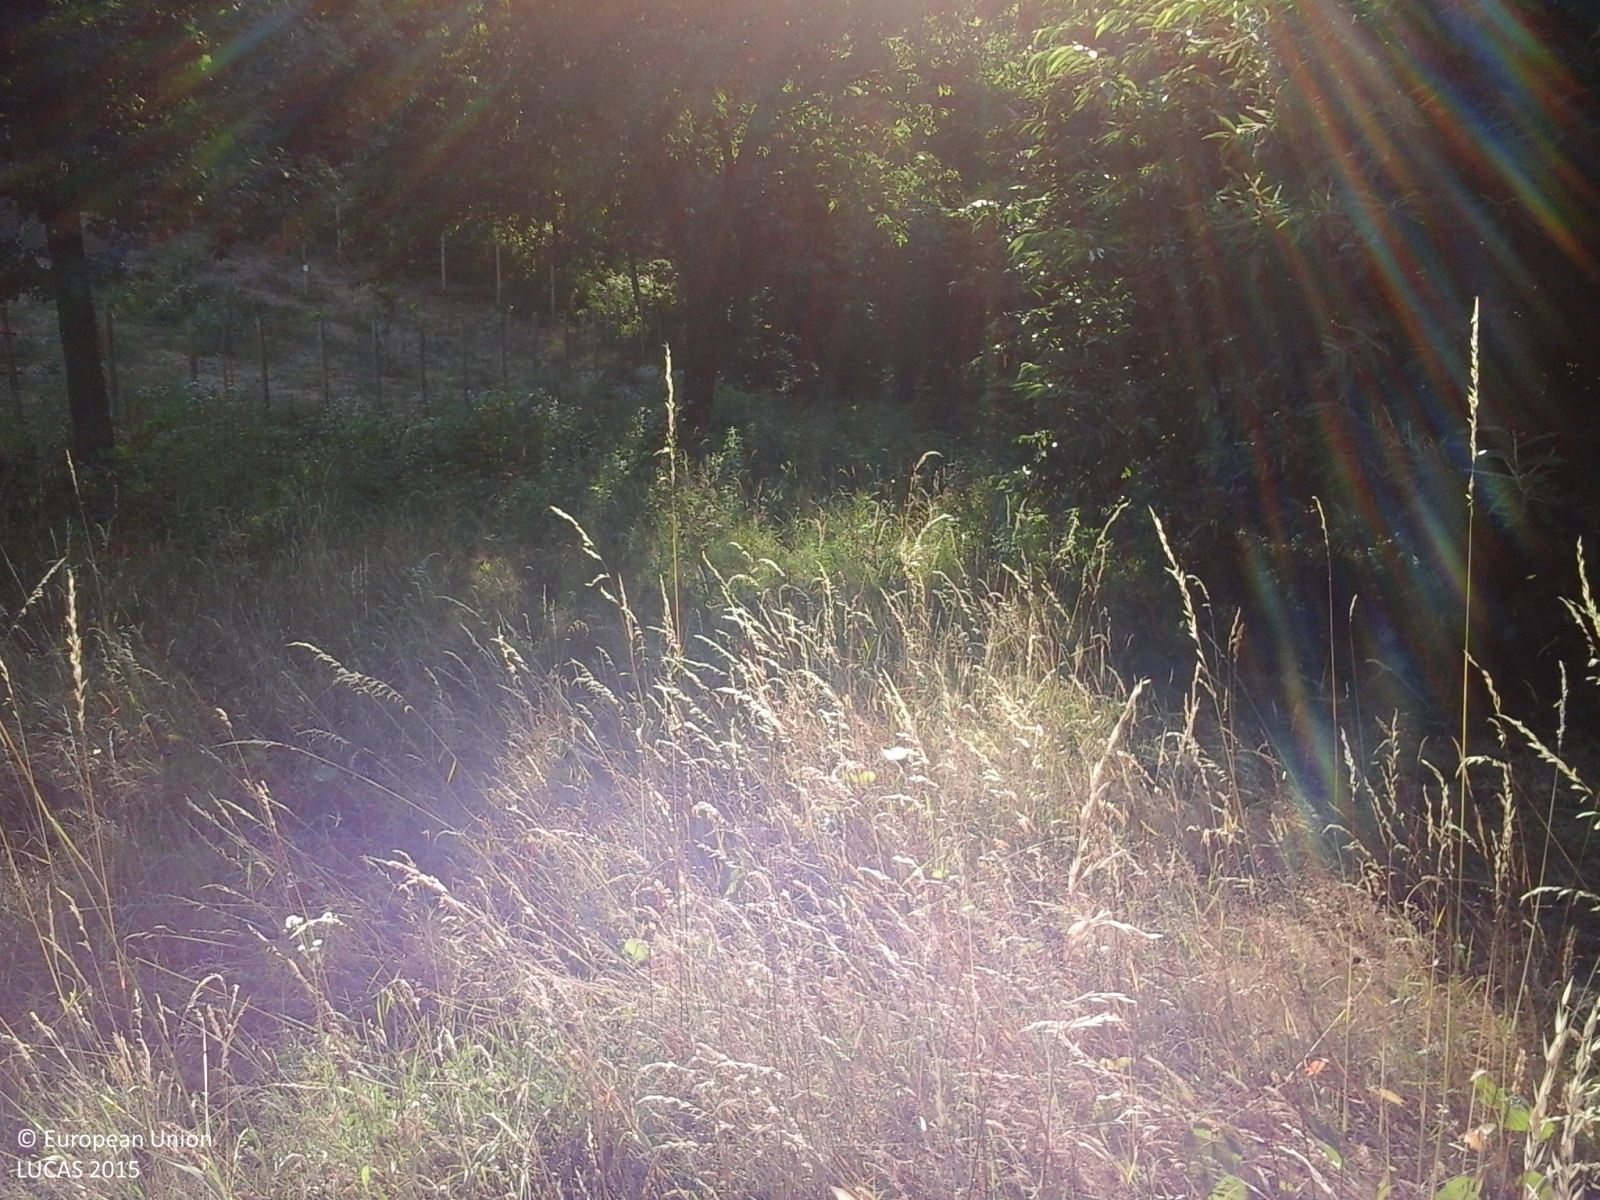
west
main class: Grassland
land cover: Grassland without tree/shrub cover
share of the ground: > 75 %
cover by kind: herbaceous plants 100 %
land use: Agriculture (excluding fallow land and kitchen gardens)
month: June
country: IT
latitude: 44.3460
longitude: 7.8346
